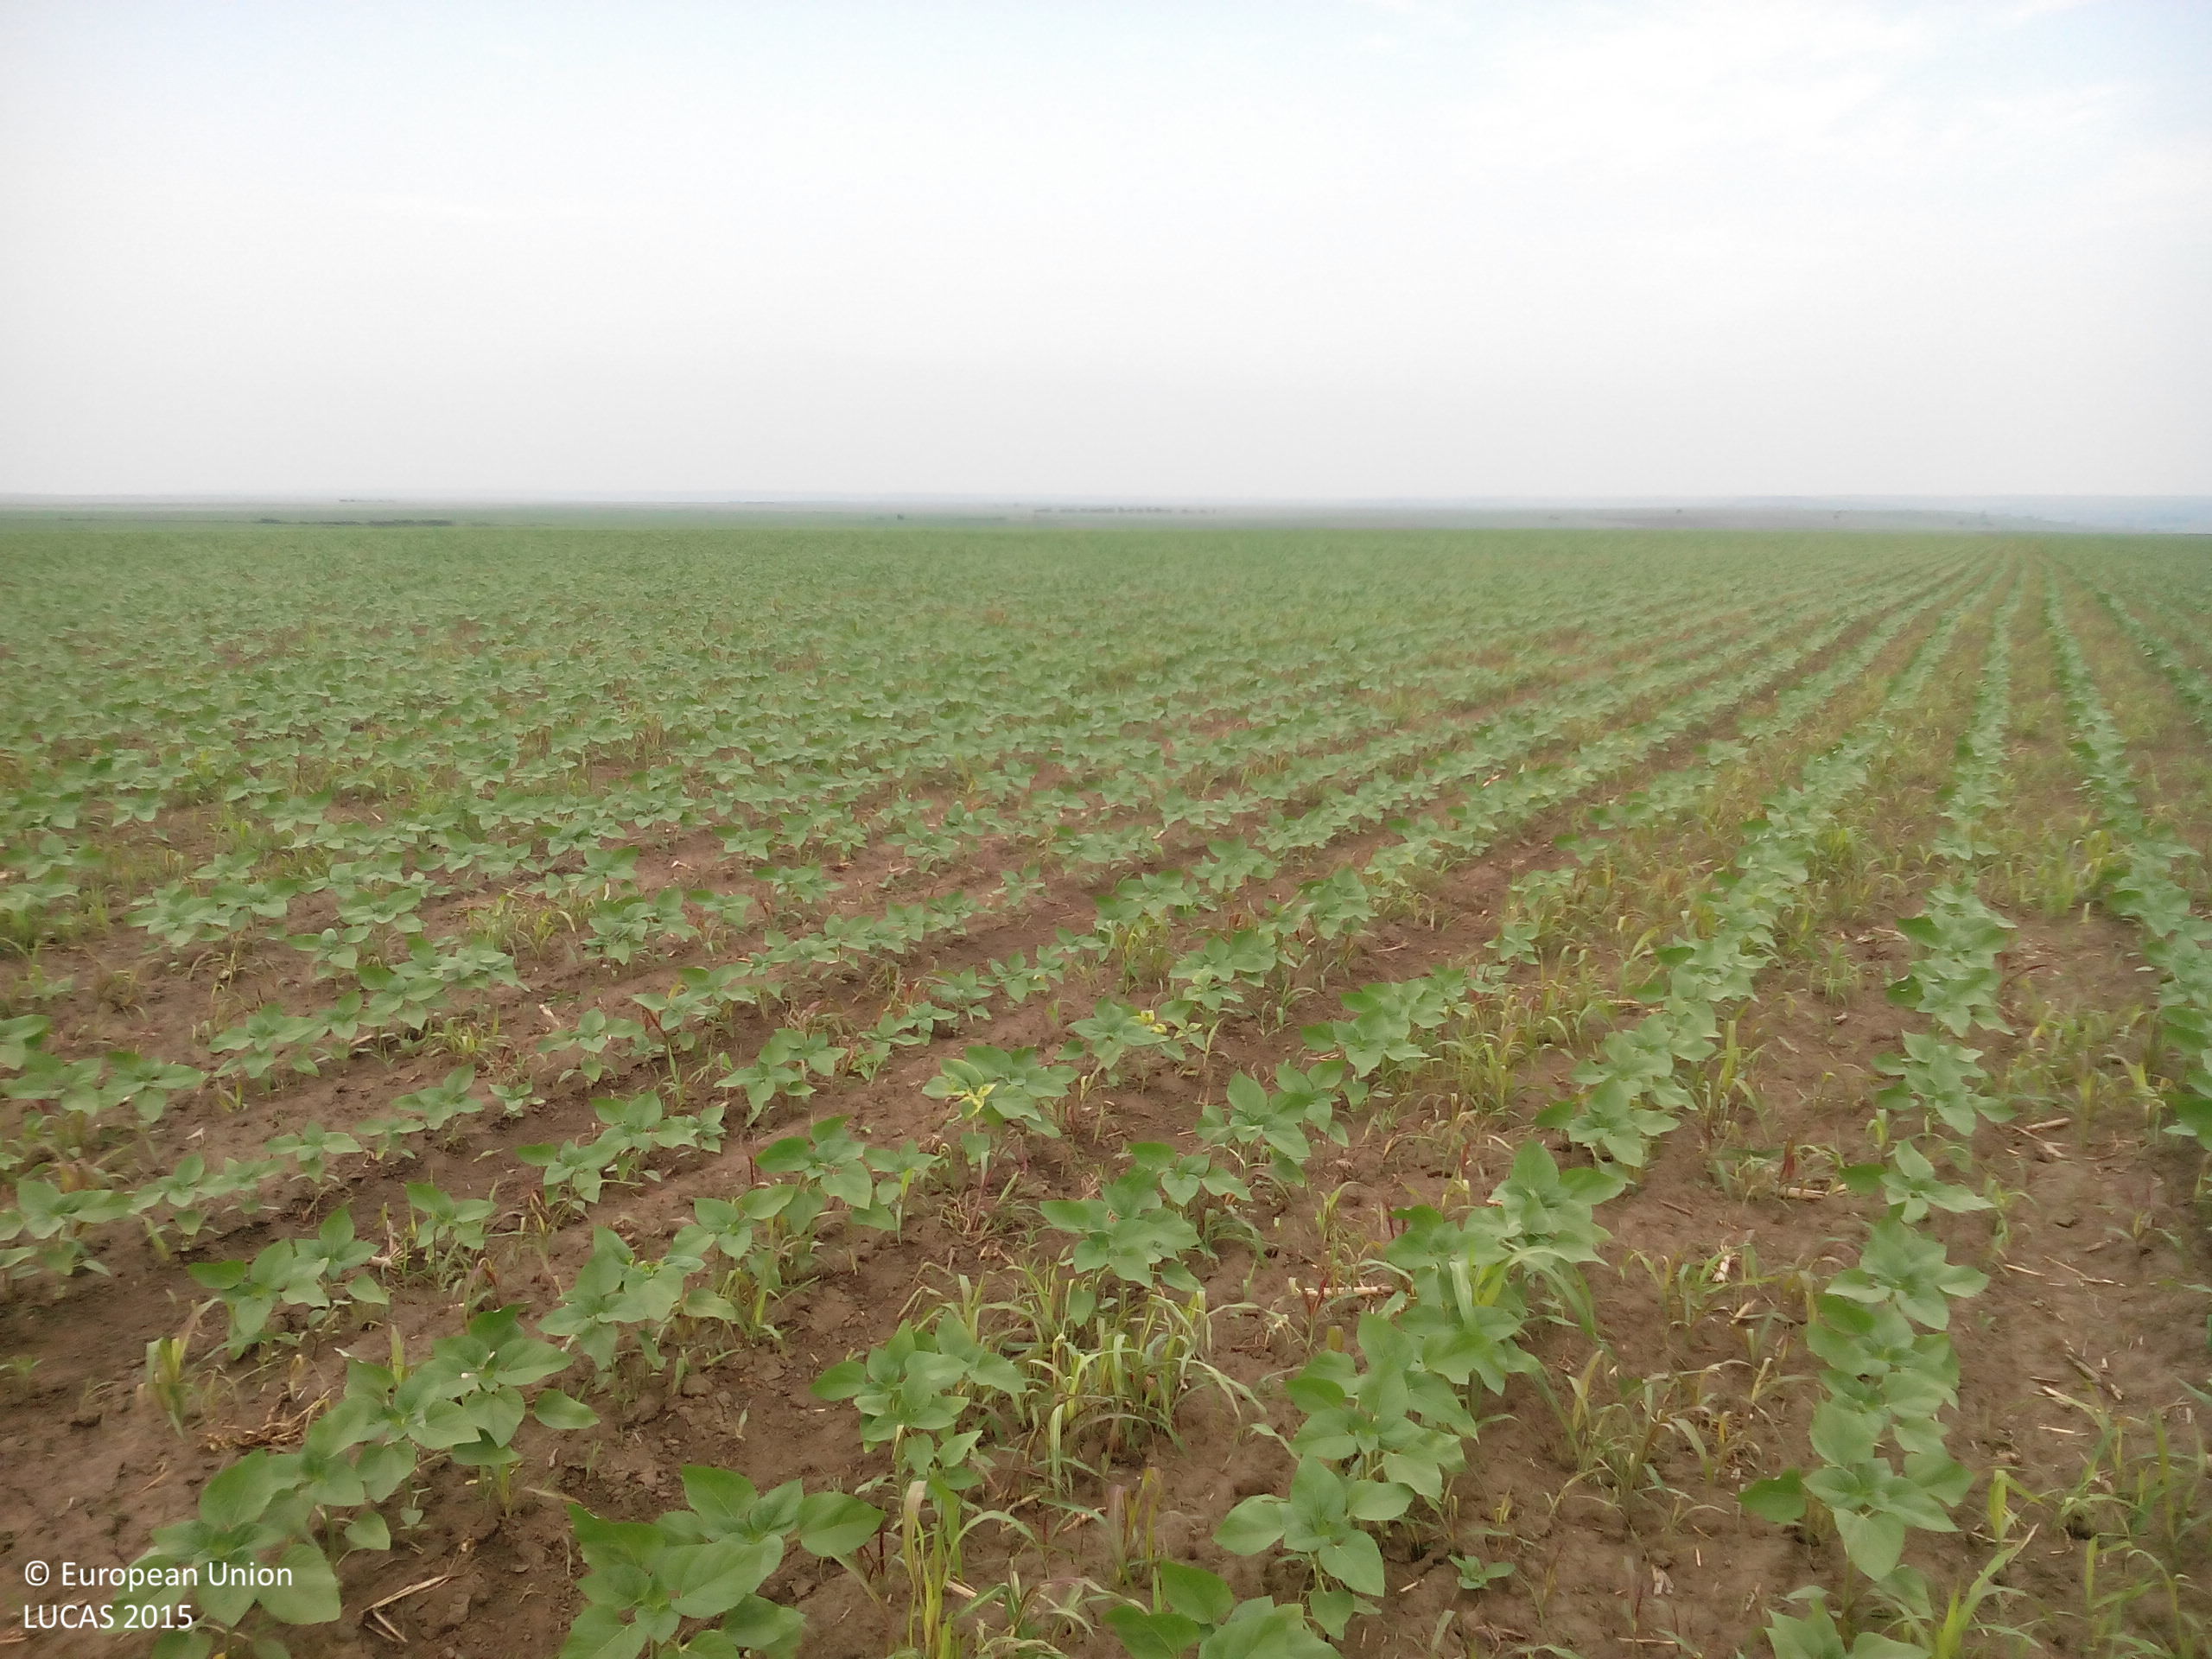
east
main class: Cropland
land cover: Sunflower
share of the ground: 25 - 50 %
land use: Agriculture (excluding fallow land and kitchen gardens)
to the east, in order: Sunflower; Grass margins; Dry pulses
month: May
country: BG
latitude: 43.6070
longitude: 24.1934
